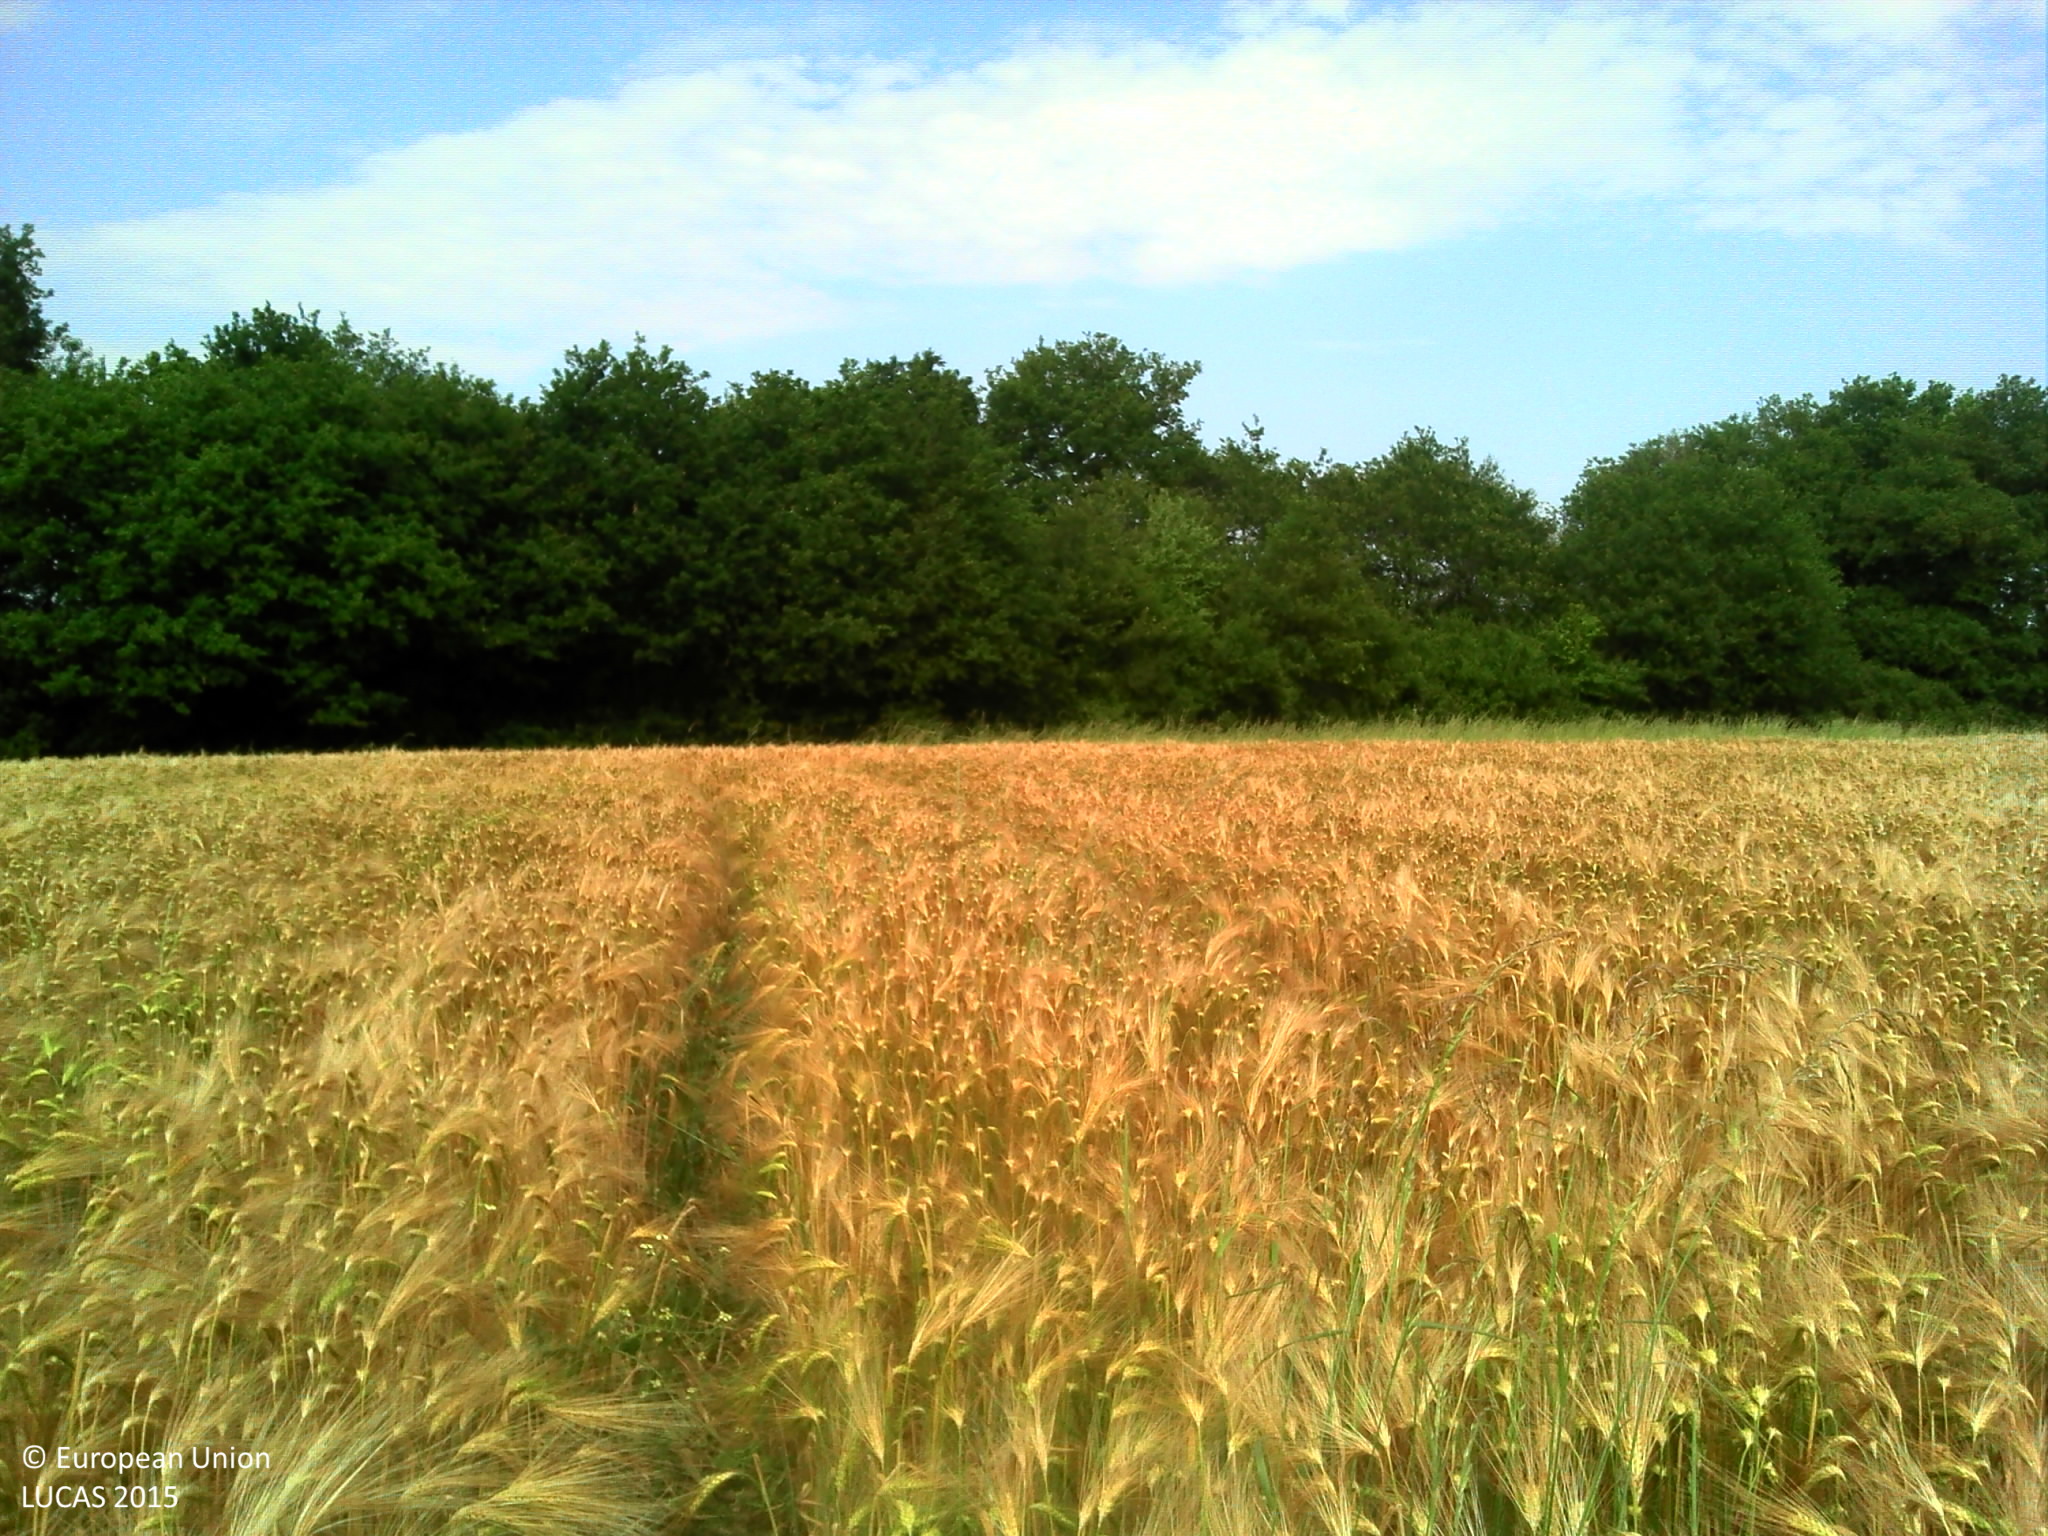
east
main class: Cropland
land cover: Barley
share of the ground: > 75 %
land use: Agriculture (excluding fallow land and kitchen gardens)
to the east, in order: Barley; Broadleaved woodland; Rivers and streams; Broadleaved woodland; Tracks; Lines of trees; Maize; Electric lines; Maize
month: June
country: FR
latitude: 46.7907
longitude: -1.7674
